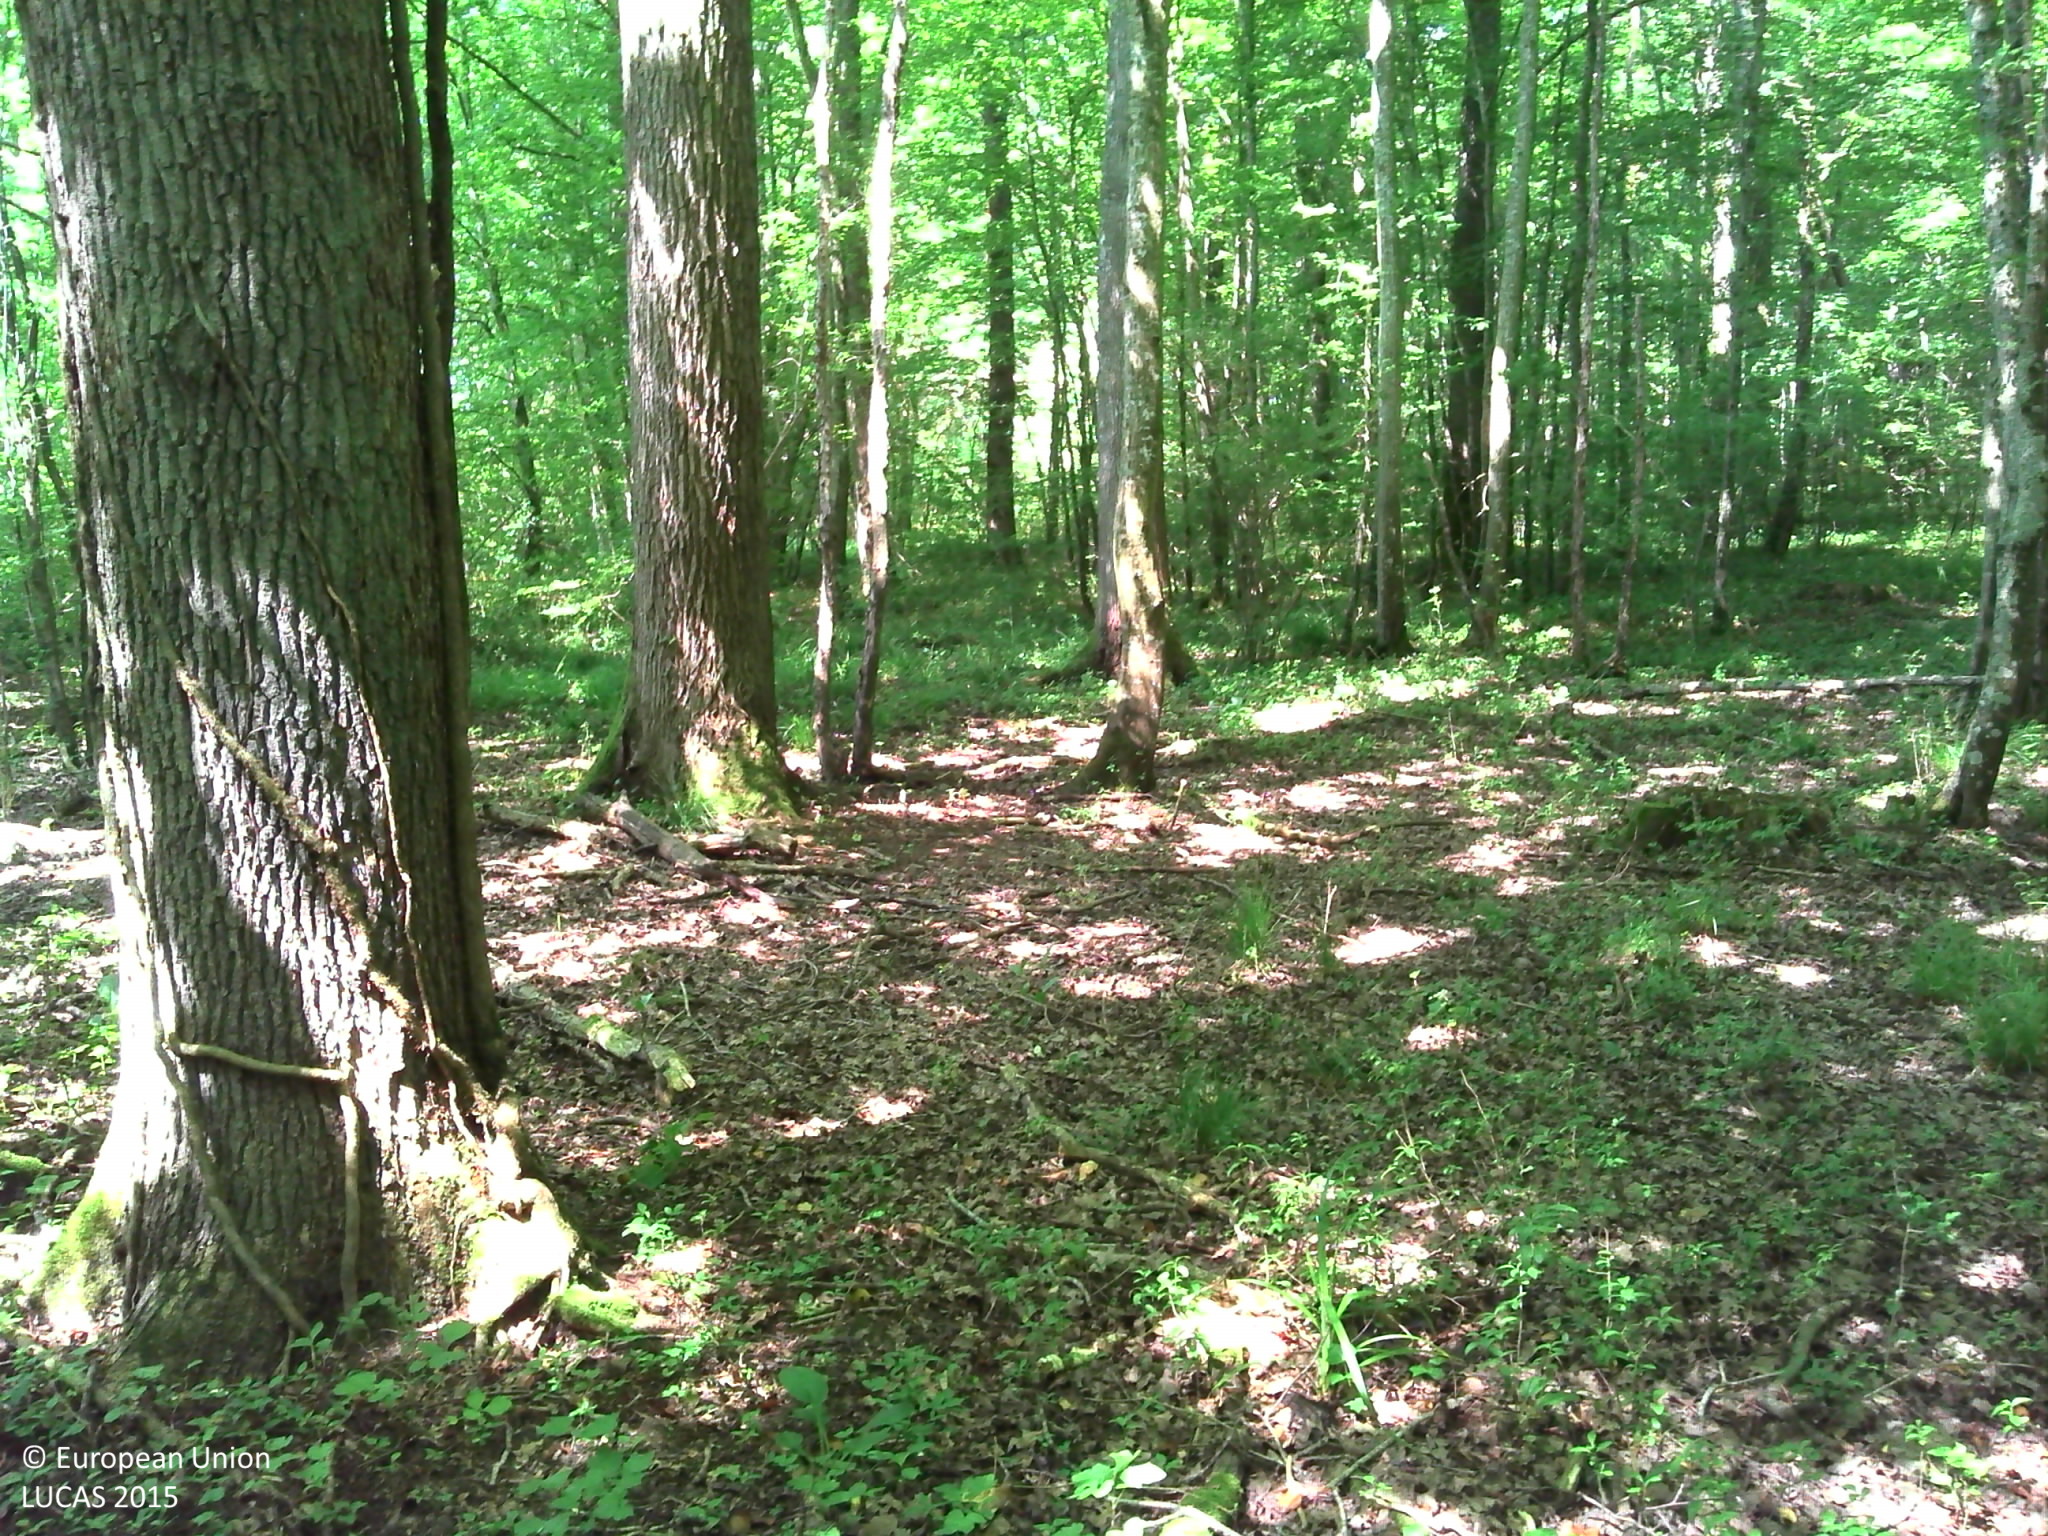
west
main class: Woodland
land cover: Broadleaved woodland
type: mesophytic deciduous forest
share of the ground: > 75 %
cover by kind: broadleaved forest trees 85 %, herbaceous plants 10 %, coniferous forest trees 5 %
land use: Forestry
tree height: > 5 m
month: June
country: FR
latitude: 48.4302
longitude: 4.9031
